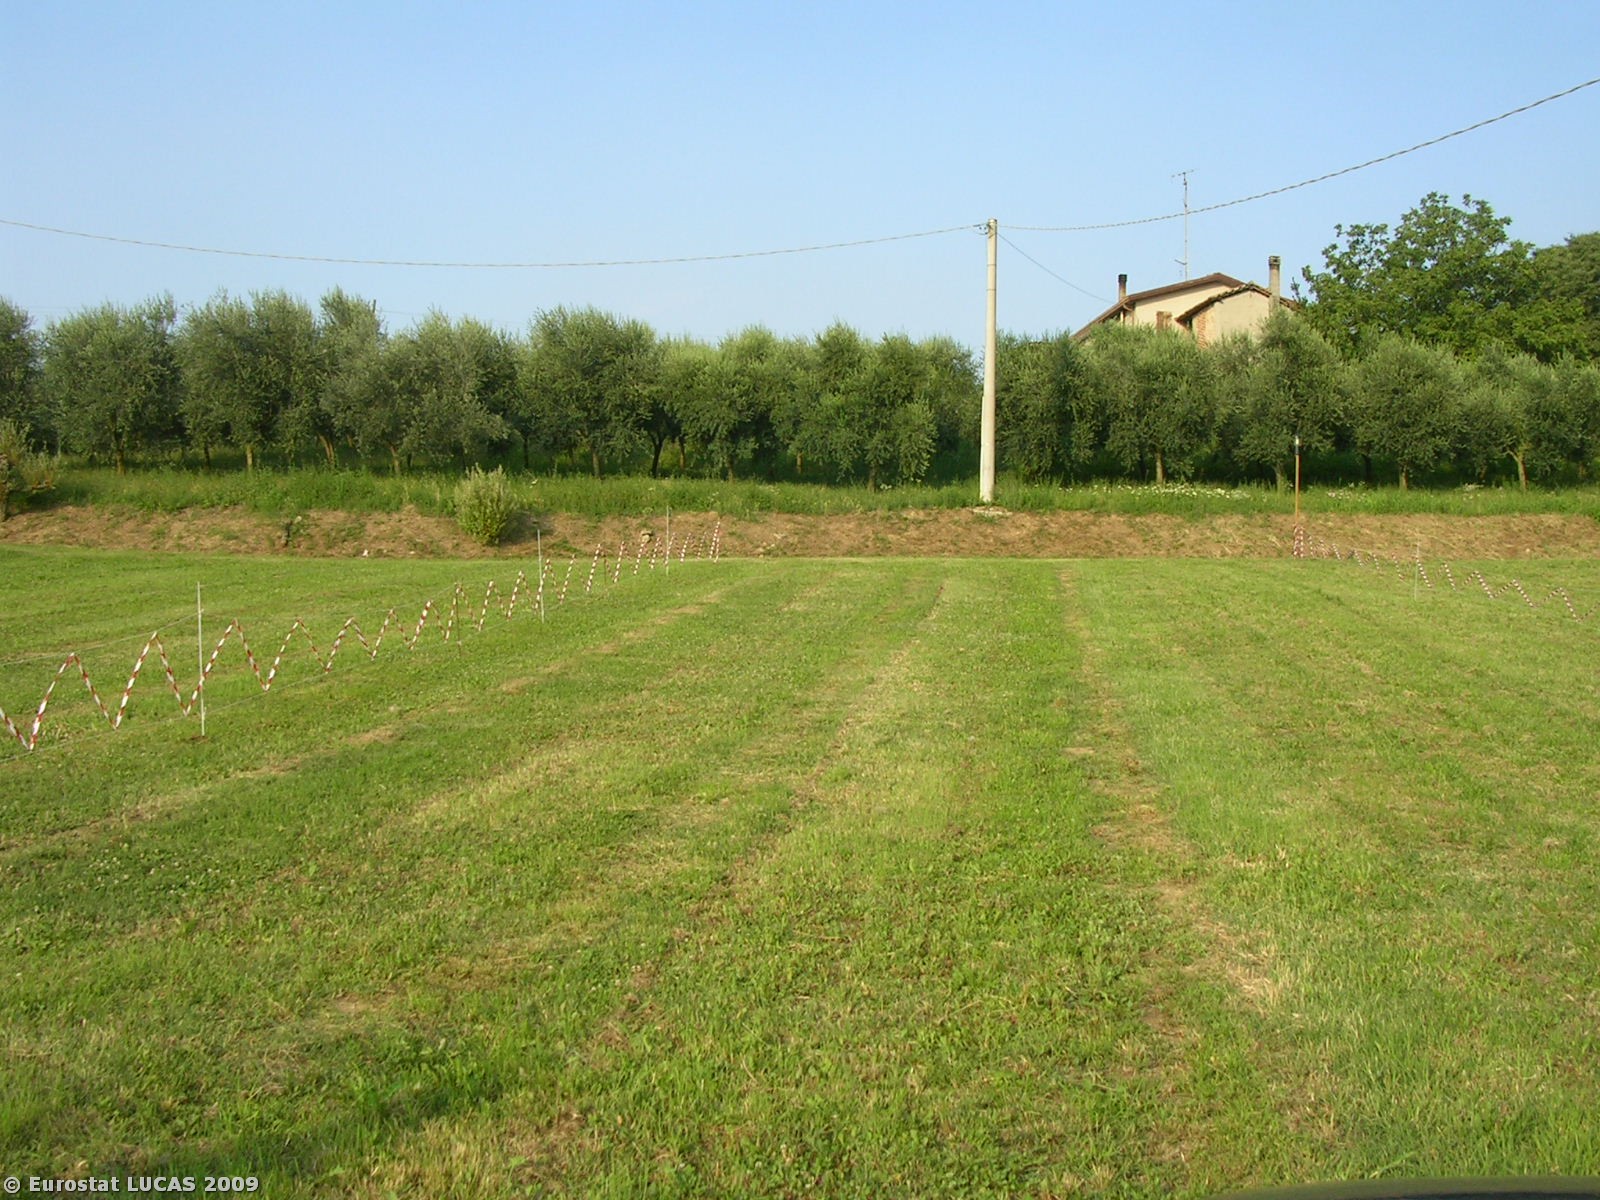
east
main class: Woodland
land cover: Broadleaved woodland
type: mesophytic deciduous forest
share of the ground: > 75 %
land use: Forestry
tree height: > 5 m
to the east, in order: Broadleaved woodland; Tracks; Broadleaved woodland
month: July
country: IT
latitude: 45.3650
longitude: 11.6697
